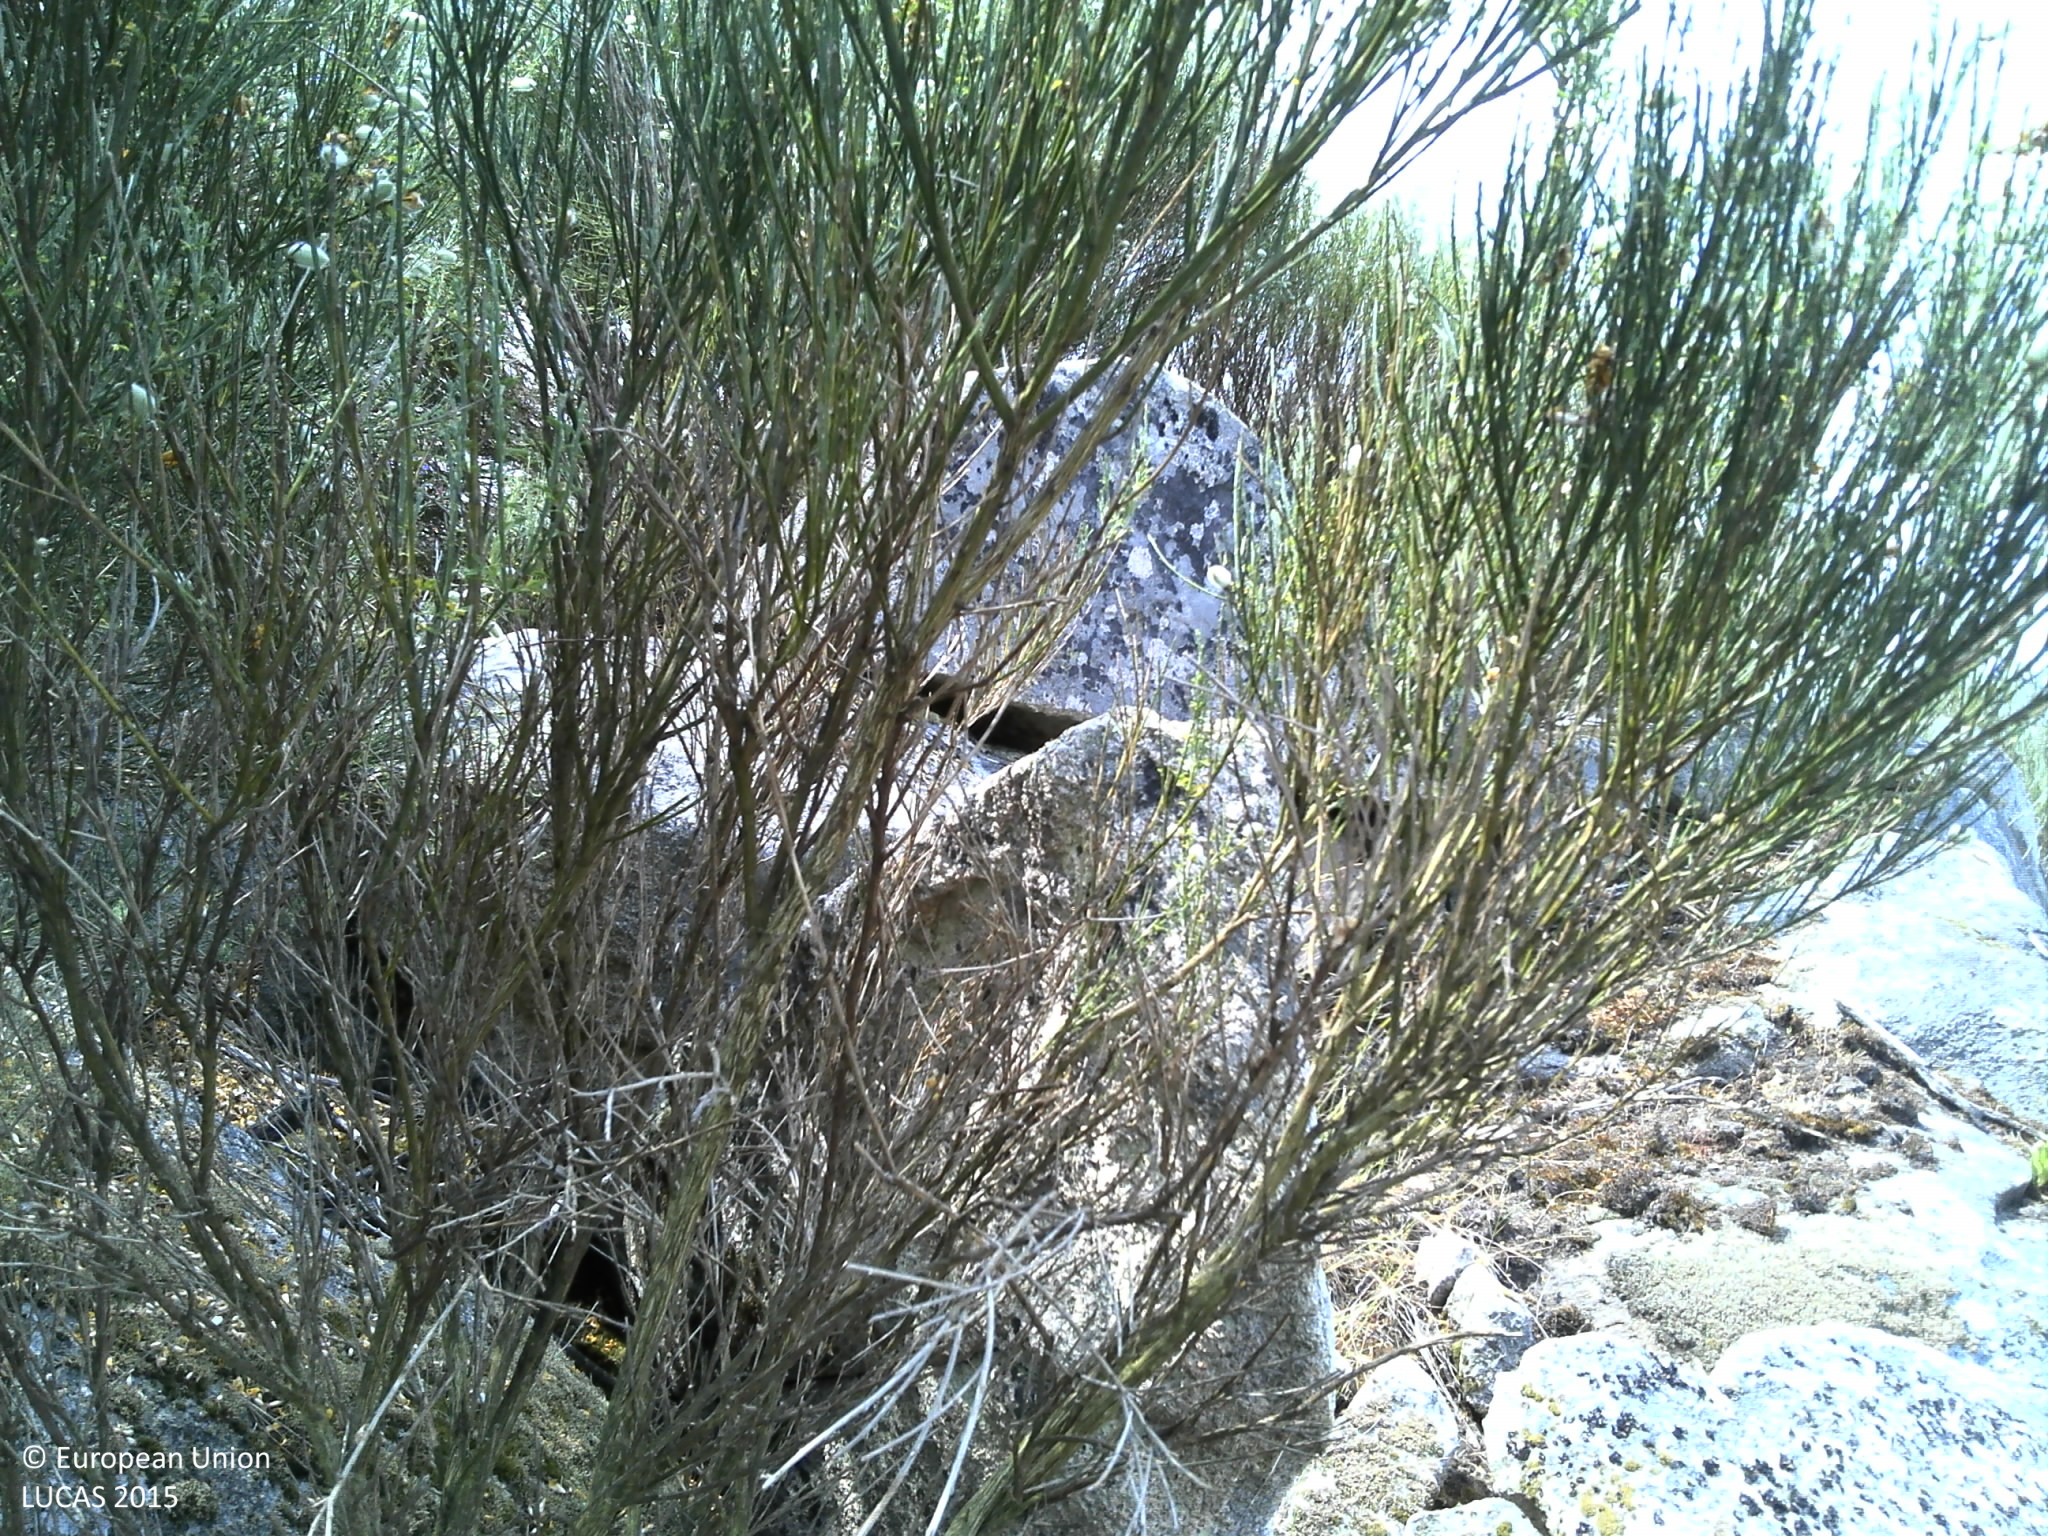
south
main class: Shrubland
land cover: Shrubland without tree cover
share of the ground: > 75 %
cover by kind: shrubs 50 %, consolidated bare surface 45 %, herbaceous plants 5 %
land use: Semi-natural and natural areas not in use
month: June
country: PT
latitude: 41.3975
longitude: -7.5782
